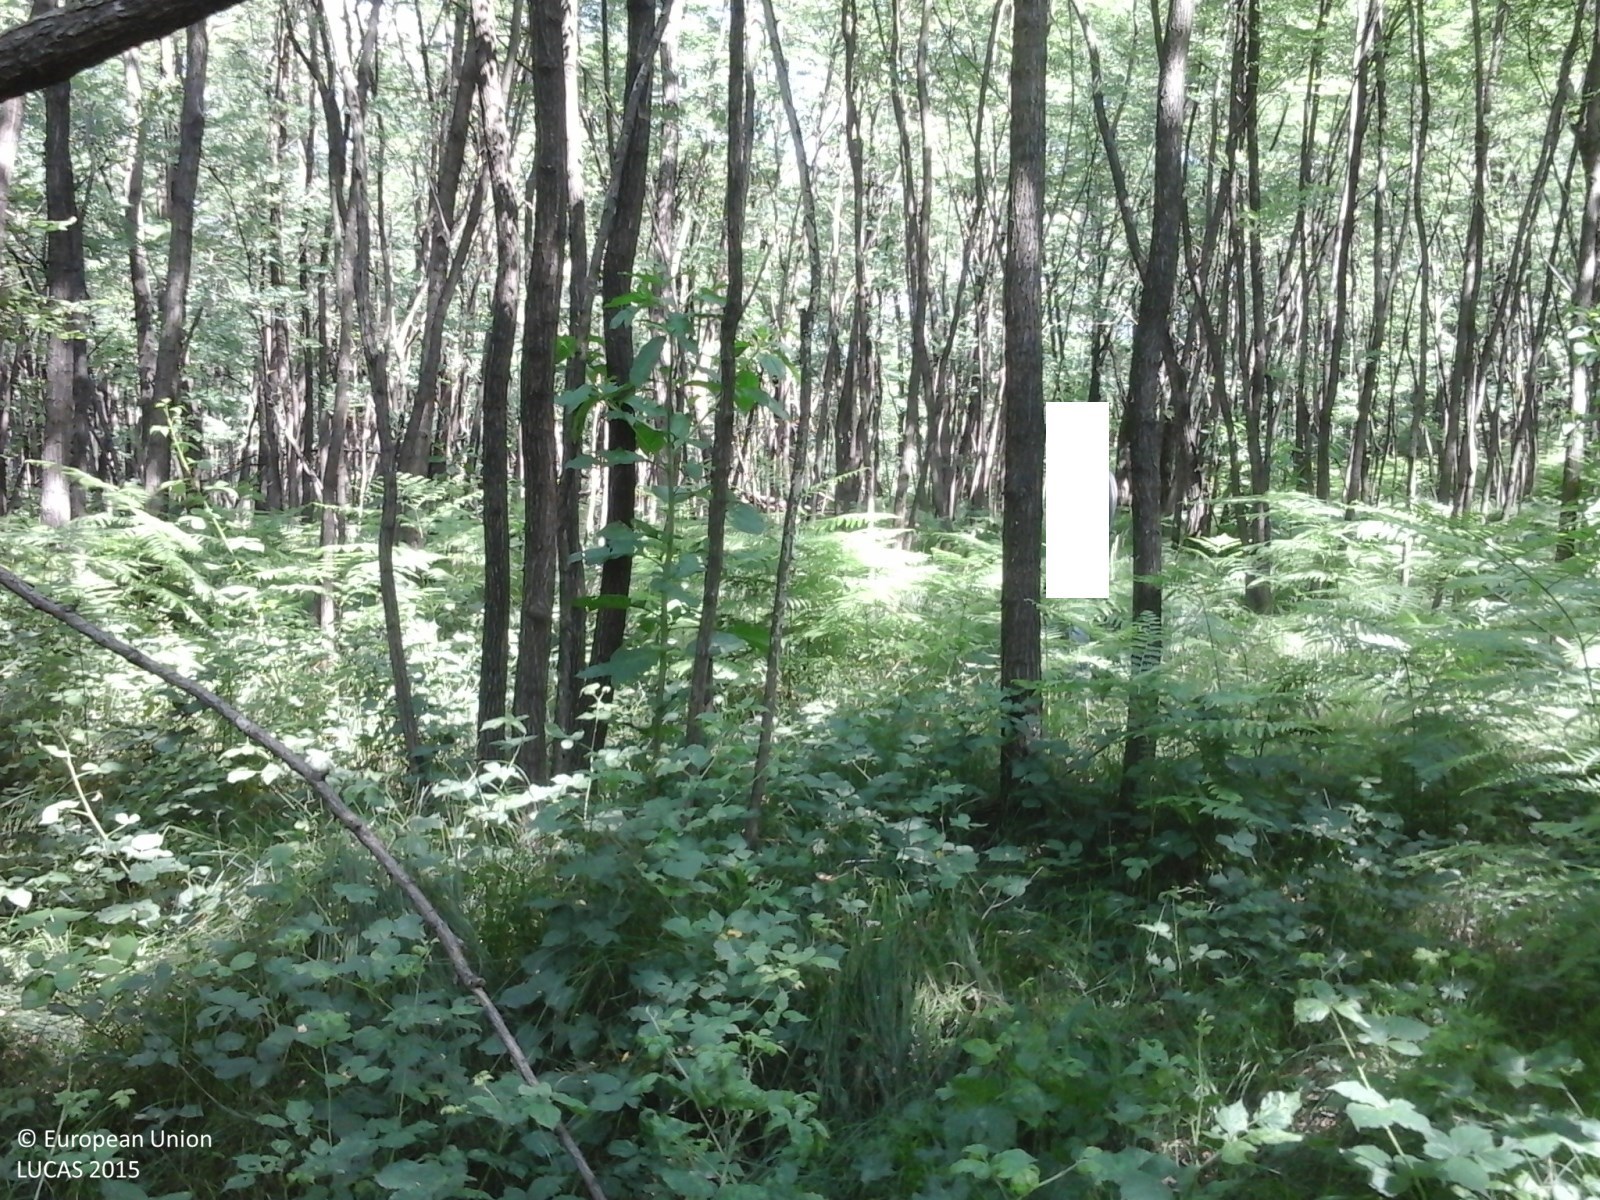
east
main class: Woodland
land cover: Broadleaved woodland
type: thermophilous deciduous forest
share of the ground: > 75 %
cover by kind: broadleaved forest trees 95 %, shrubs 5 %
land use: Forestry
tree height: > 5 m
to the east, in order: Broadleaved woodland; Inland fresh running water; Broadleaved woodland
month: June
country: IT
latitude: 45.7179
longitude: 9.2432
